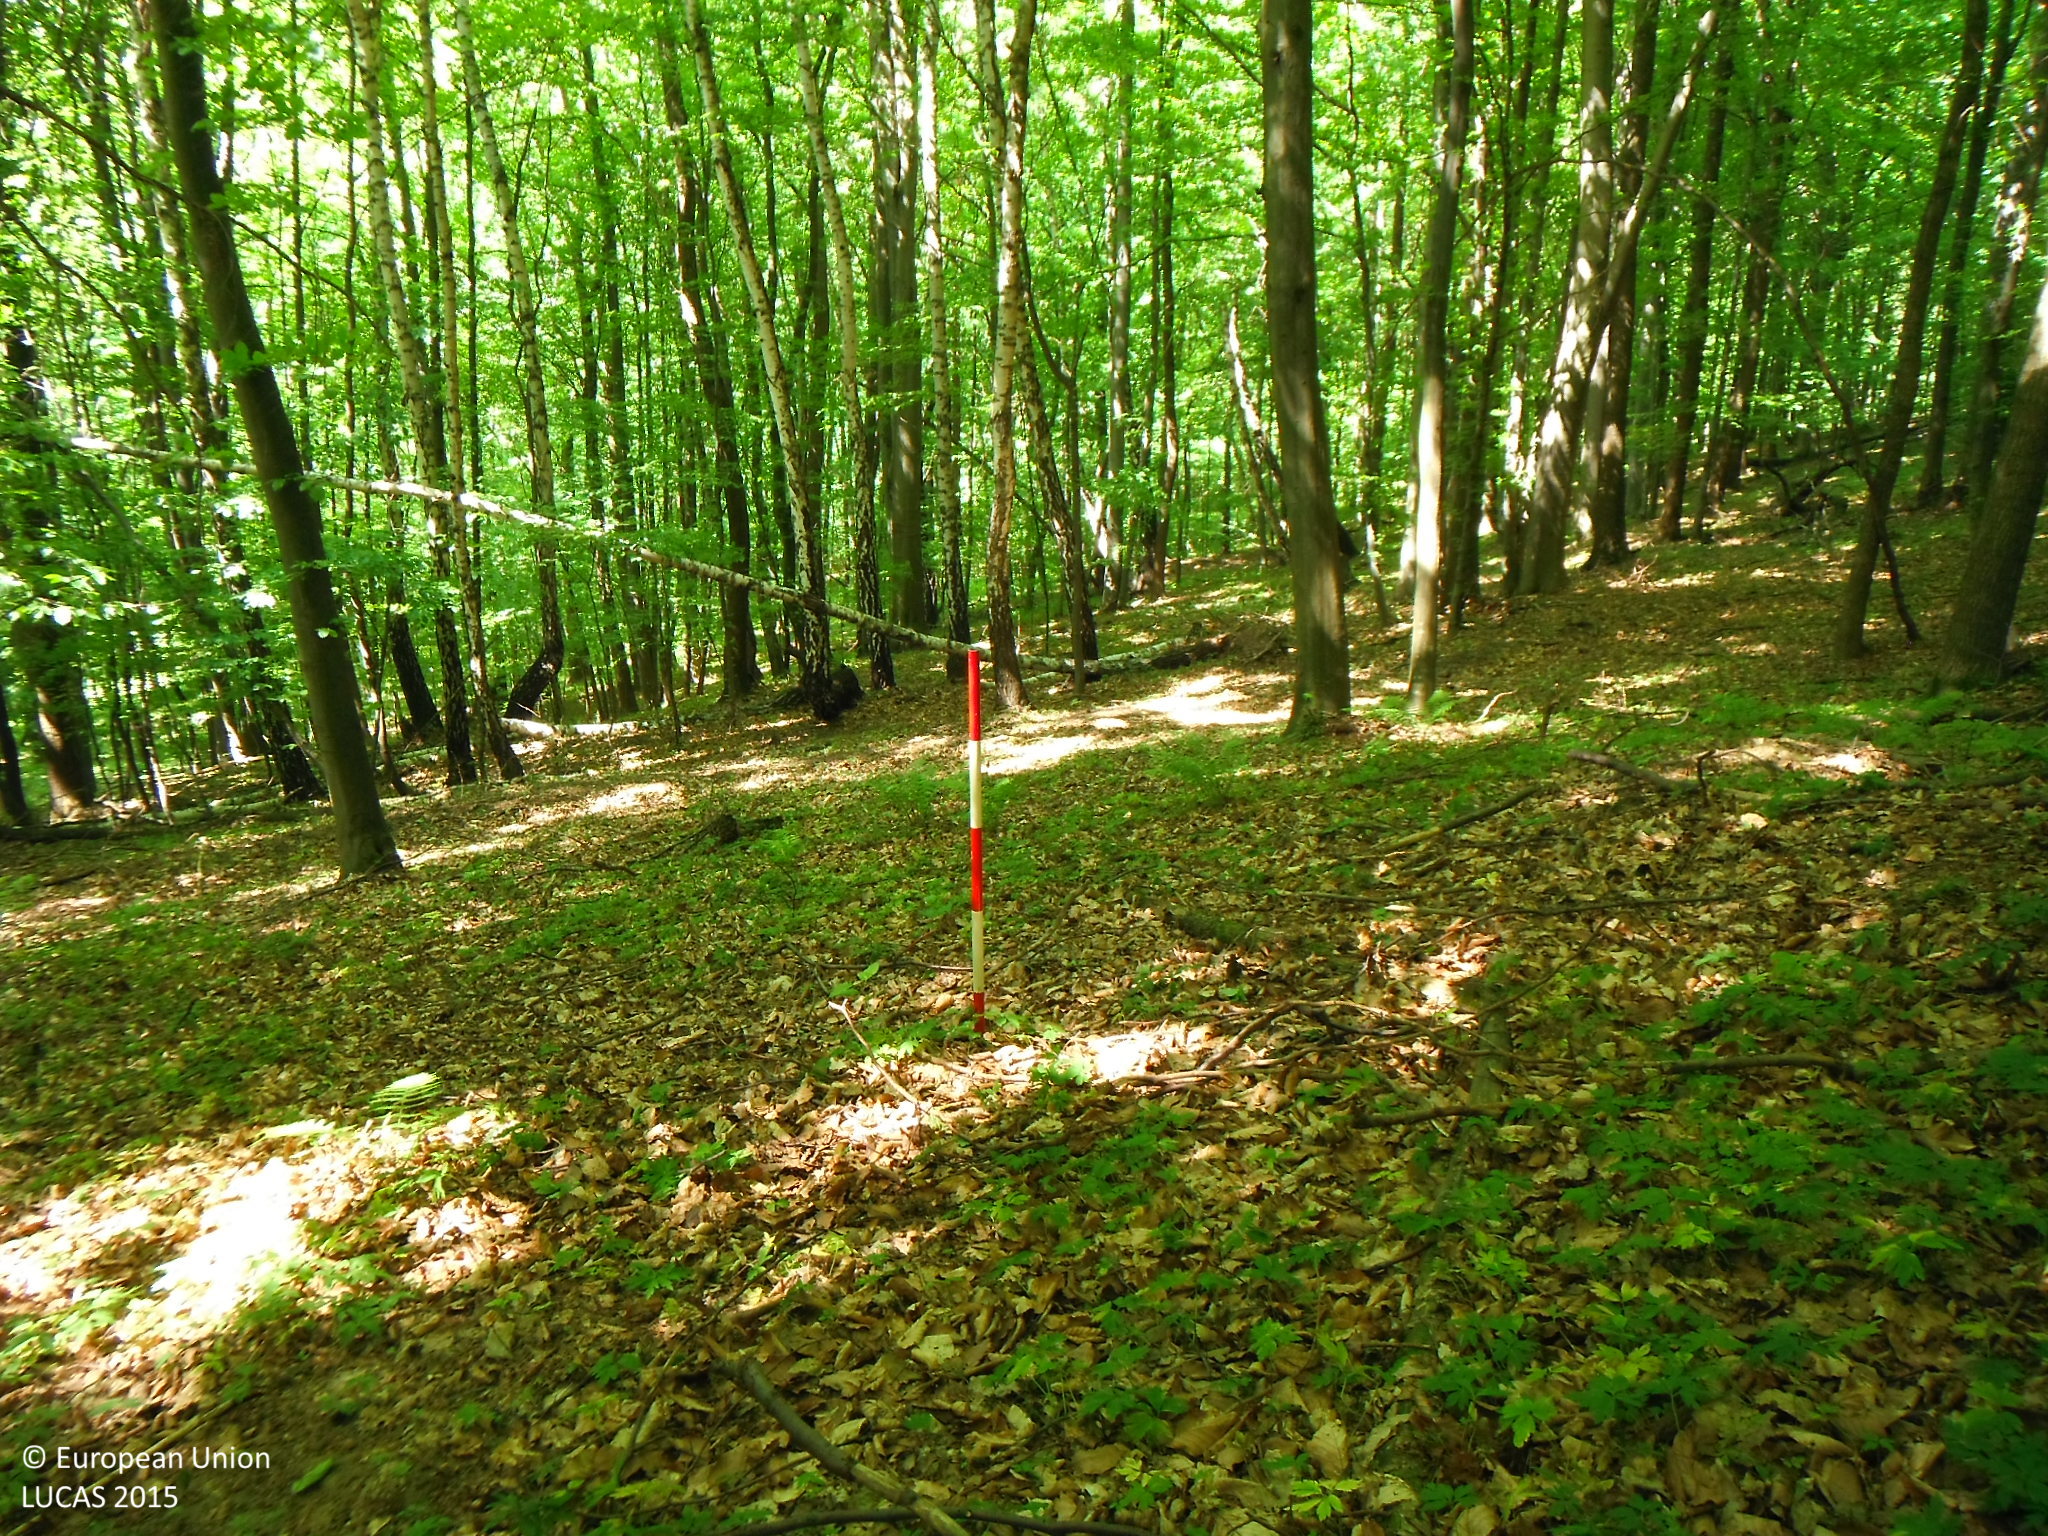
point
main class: Woodland
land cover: Broadleaved woodland
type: mesophytic deciduous forest
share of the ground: > 75 %
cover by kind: broadleaved forest trees 85 %, coniferous forest trees 15 %
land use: Forestry
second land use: Amenities, museums, leisure
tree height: > 5 m
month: May
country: SK
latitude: 48.9968
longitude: 21.7101
